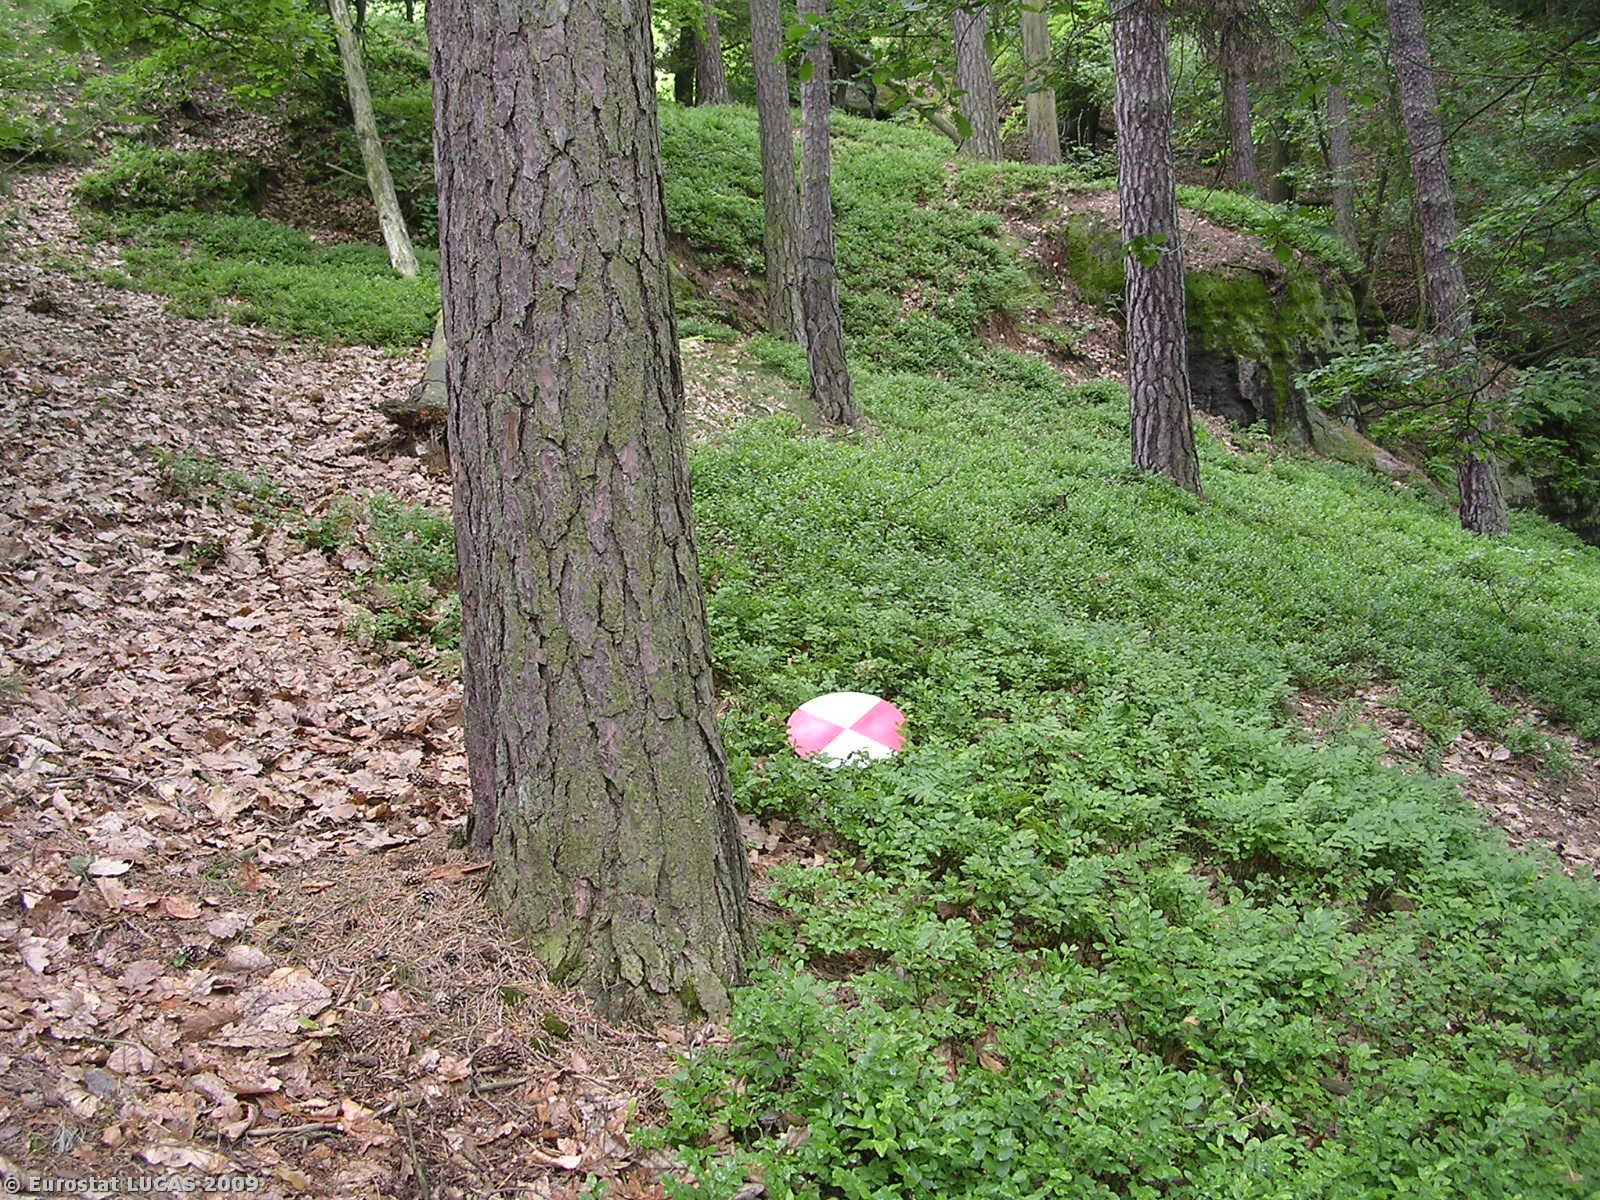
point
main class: Woodland
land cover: Mixed woodland
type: hemiboreal forest and nemoral coniferous forest and mixed broadleaved-coniferous forest
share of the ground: > 75 %
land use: Forestry
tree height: > 5 m
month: June
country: CZ
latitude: 50.5086
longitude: 14.5282
